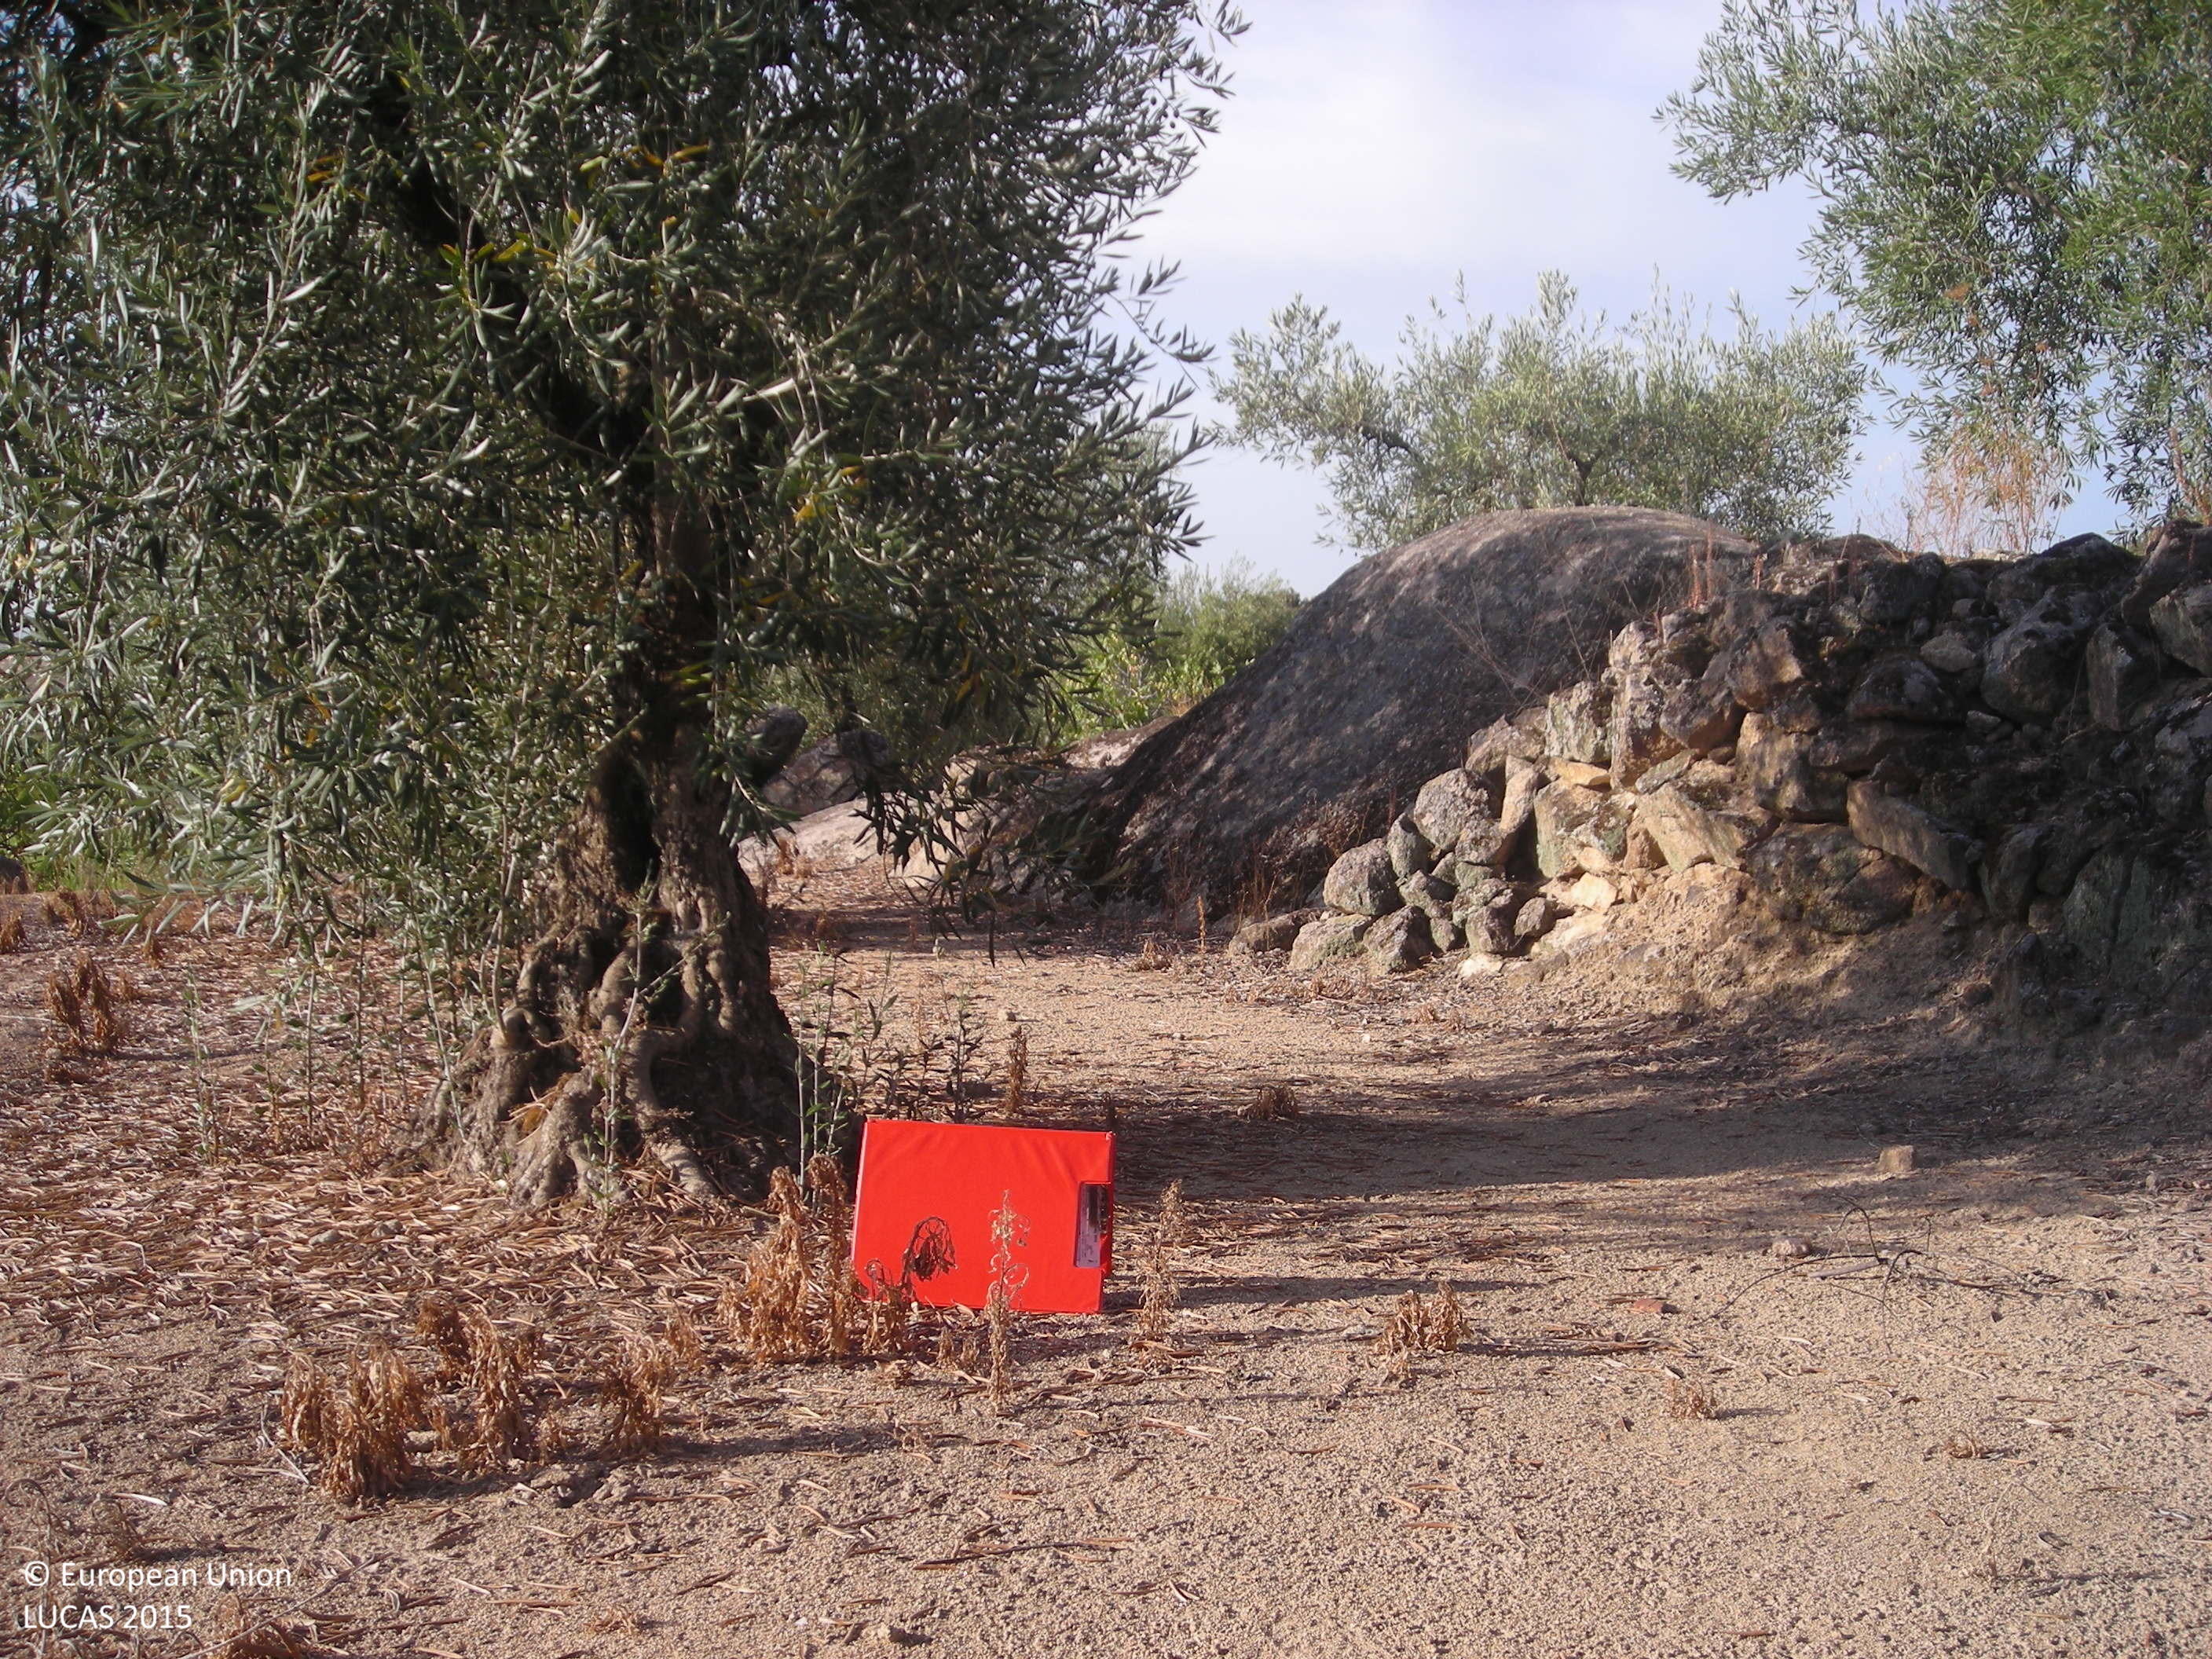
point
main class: Cropland
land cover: Olive groves
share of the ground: 50 - 75 %
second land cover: Other bare soil
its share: > 75 %
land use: Agriculture (excluding fallow land and kitchen gardens)
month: July
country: ES
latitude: 39.1566
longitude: -5.9429
